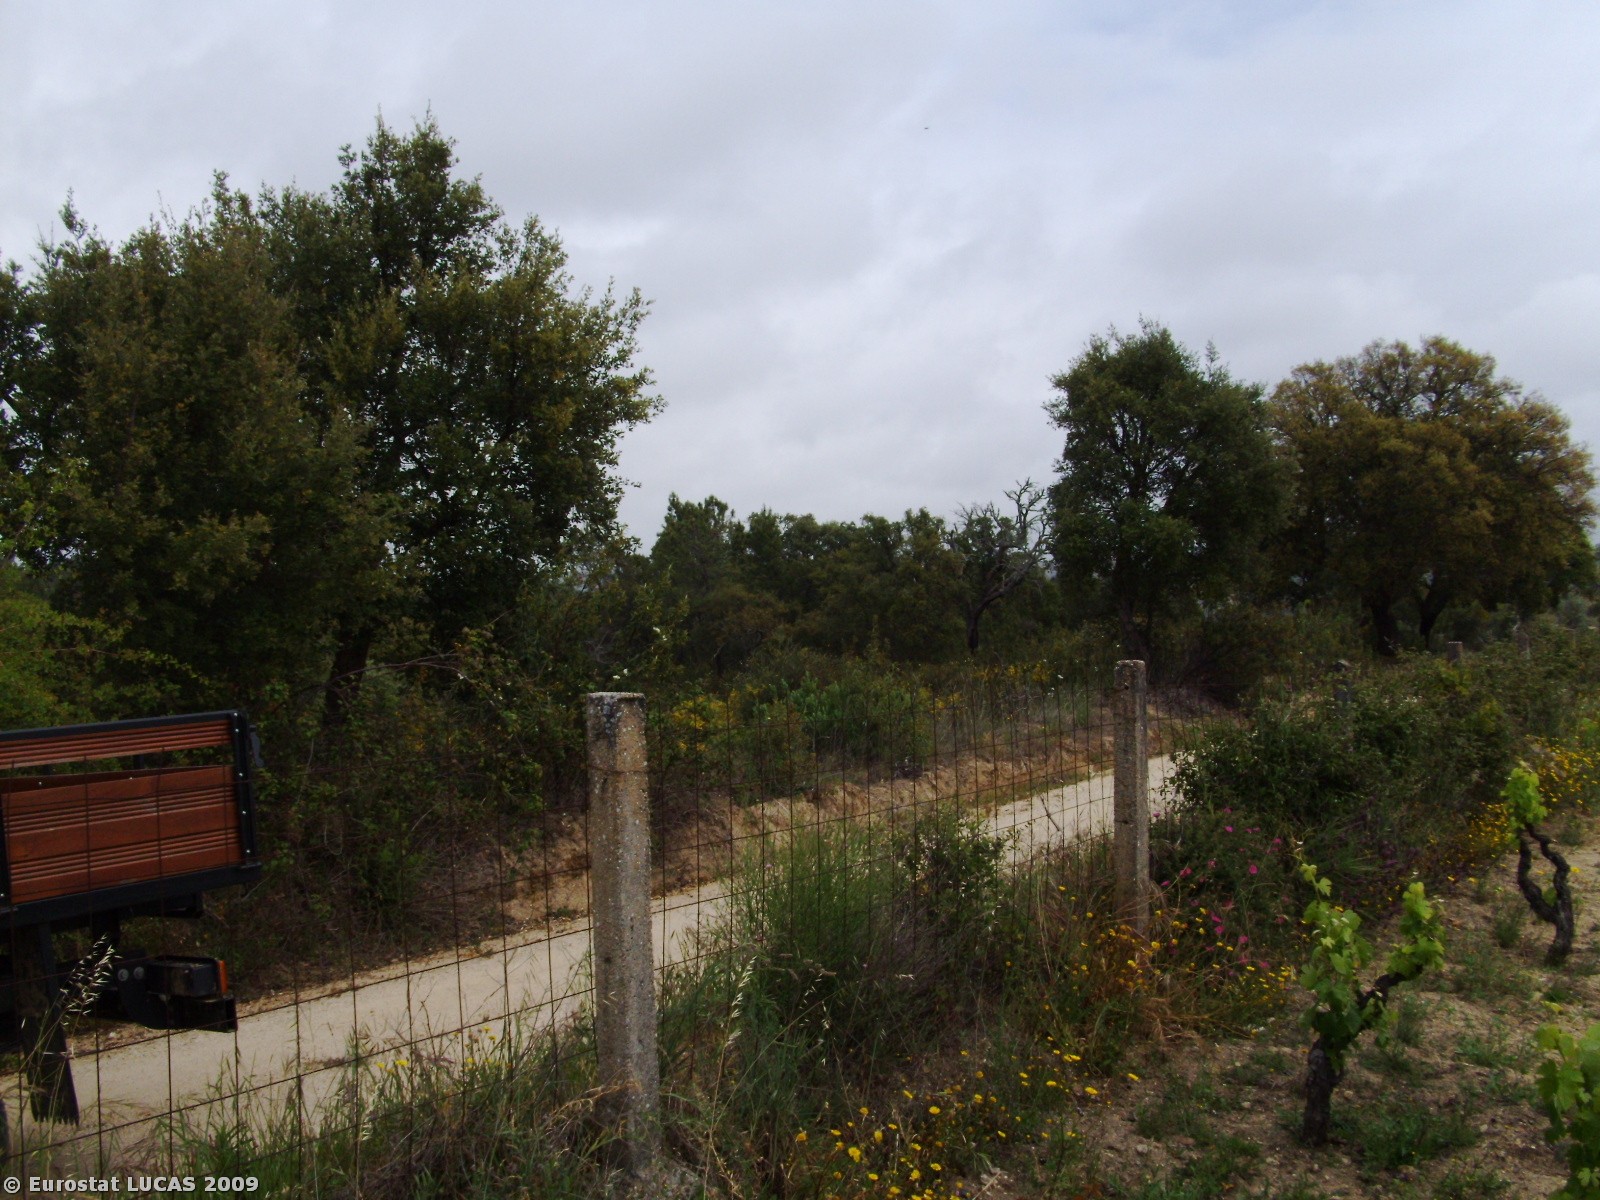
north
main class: Cropland
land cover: Vineyards
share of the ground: 10 - 25 %
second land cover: Bare land
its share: > 75 %
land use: Agriculture (excluding fallow land and kitchen gardens)
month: April
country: PT
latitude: 39.8702
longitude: -7.5563
